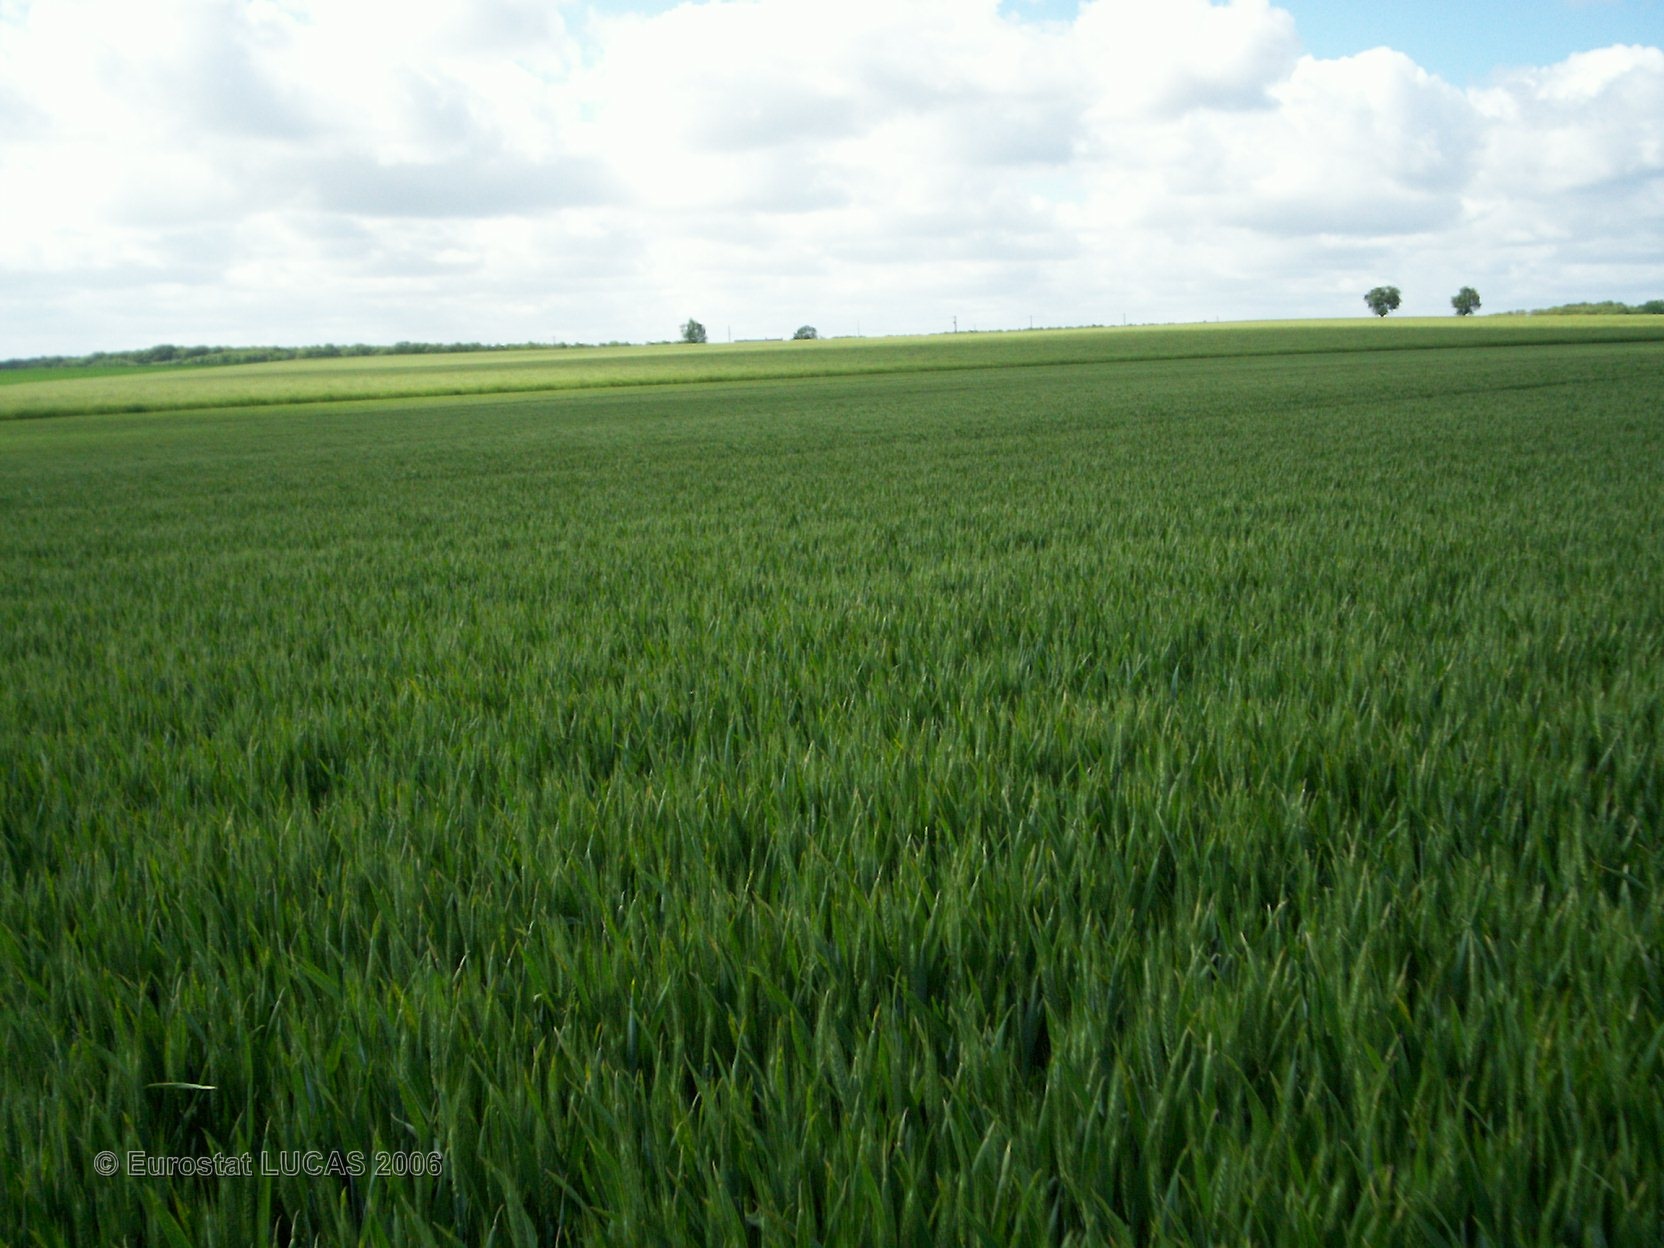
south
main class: Cropland
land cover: Common wheat
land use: Agriculture (excluding fallow land and kitchen gardens)
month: May
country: FR
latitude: 47.5884
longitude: 0.8457
